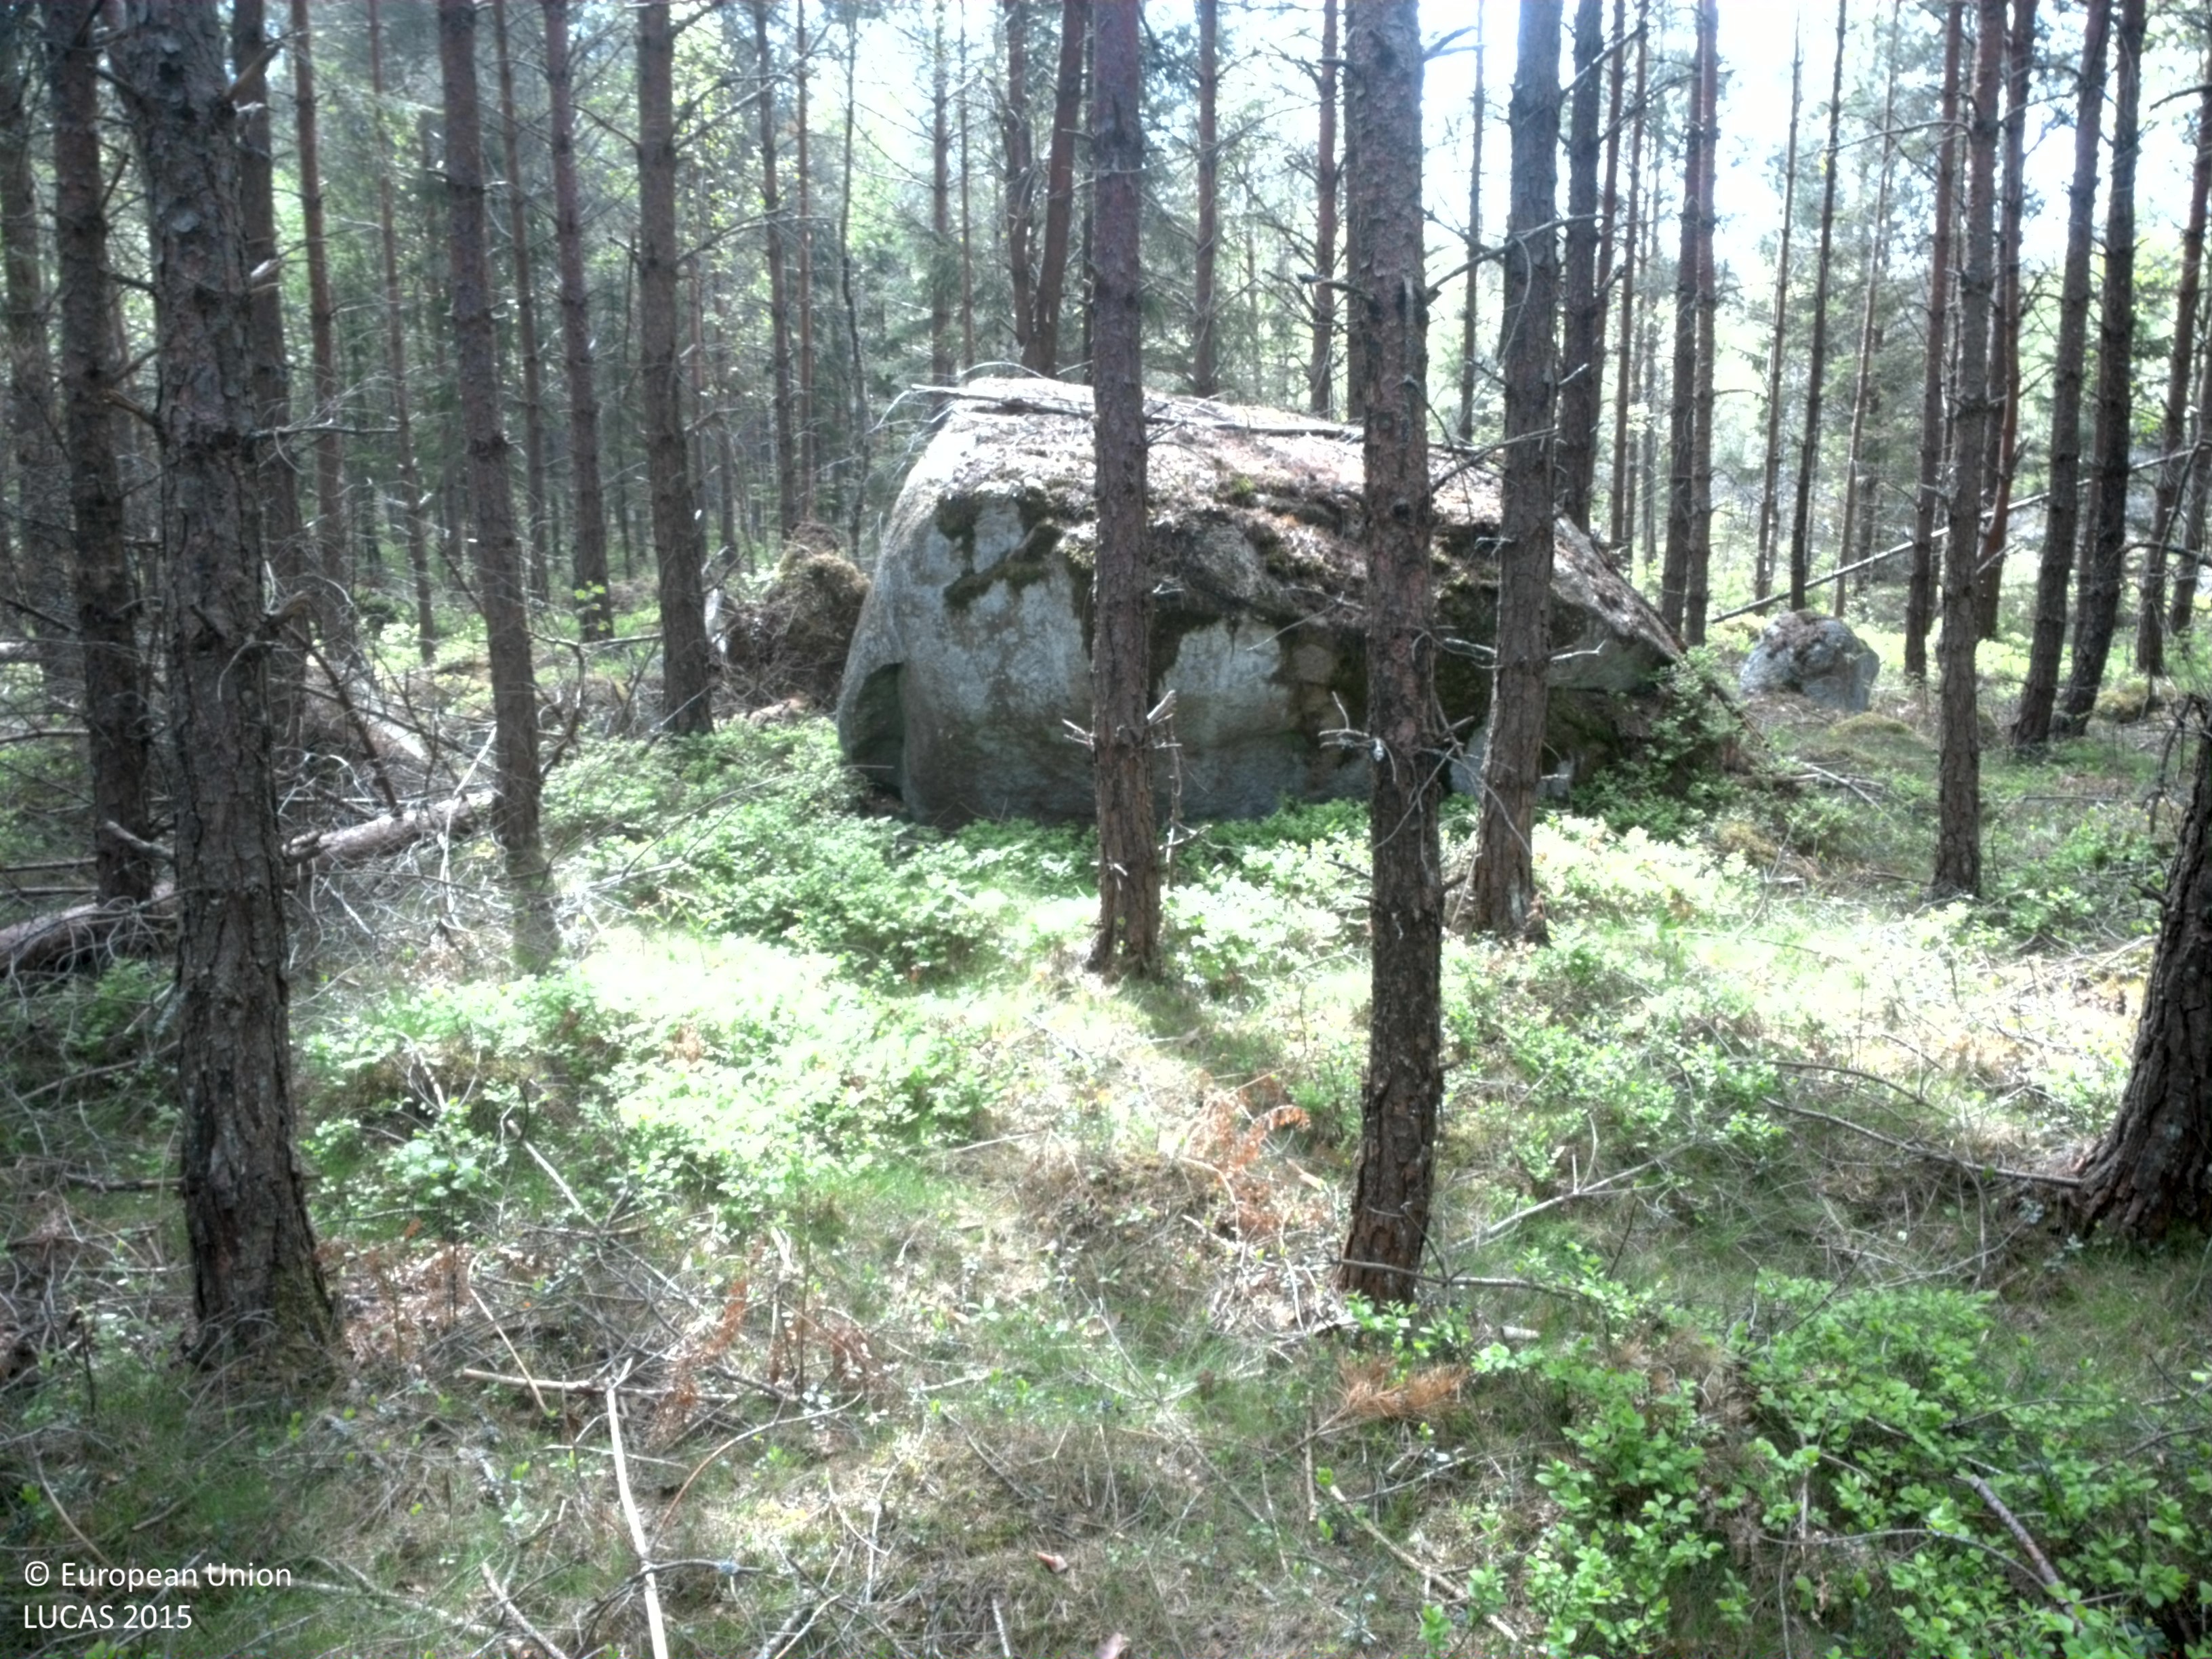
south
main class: Woodland
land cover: Pine dominated coniferous woodland
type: boreal forest
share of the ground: > 75 %
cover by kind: coniferous forest trees 85 %, shrubs 15 %
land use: Forestry
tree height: > 5 m
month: May
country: SE
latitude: 56.5514
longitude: 15.1876
